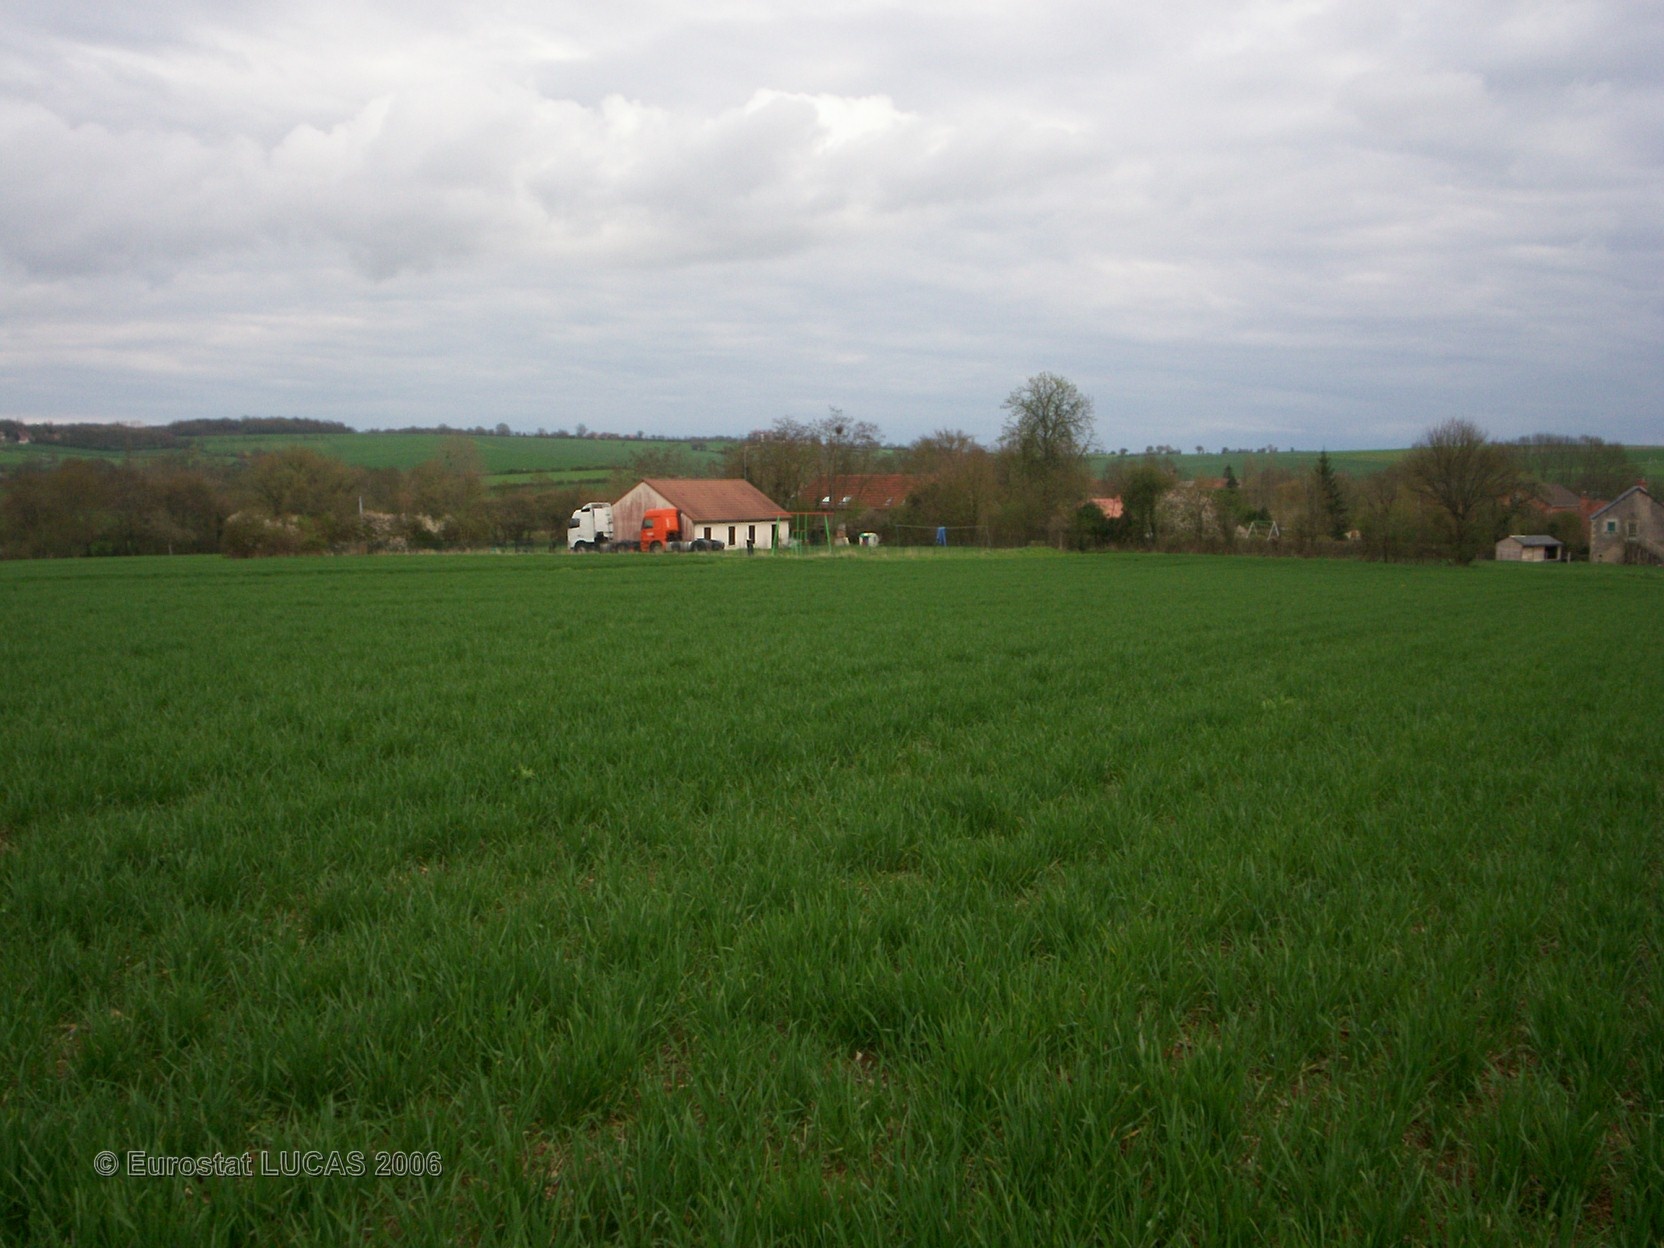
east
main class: Cropland
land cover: Common wheat
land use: Agriculture (excluding fallow land and kitchen gardens)
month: April
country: FR
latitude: 47.4414
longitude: 3.0062
